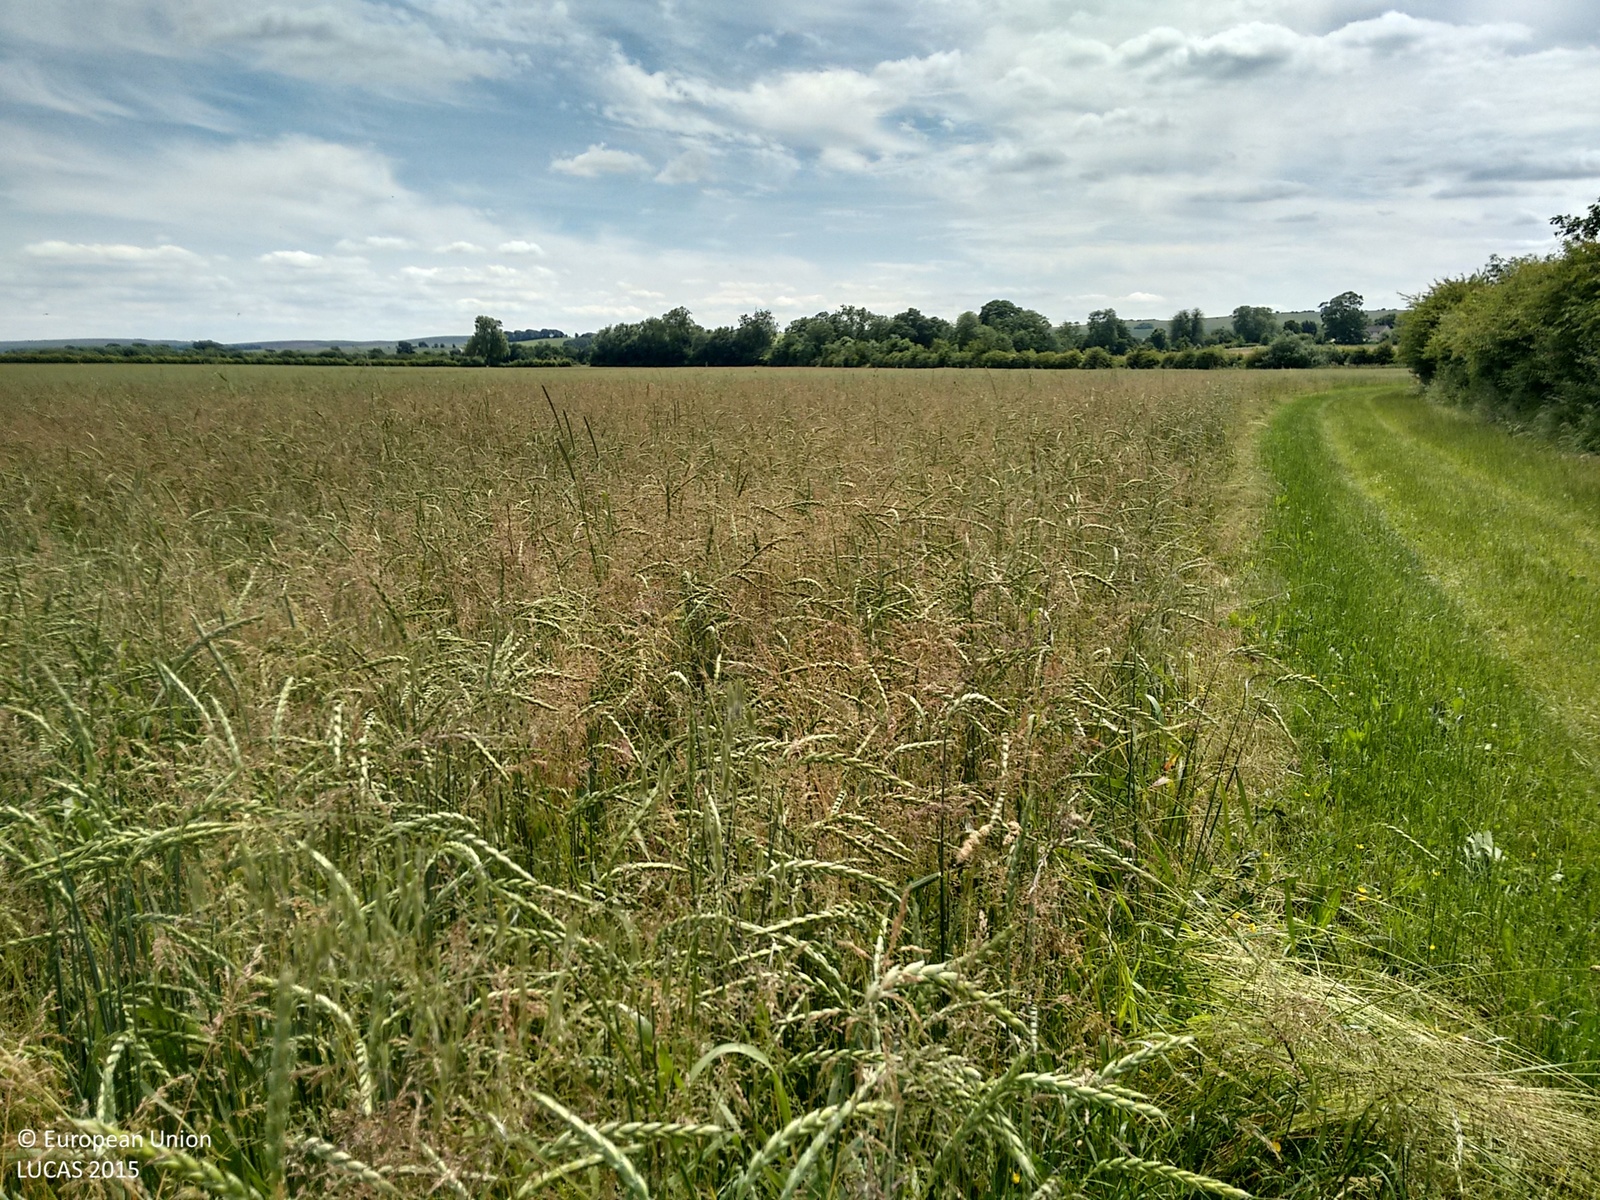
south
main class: Cropland
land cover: Mixed cereals for fodder
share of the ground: > 75 %
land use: Agriculture (excluding fallow land and kitchen gardens)
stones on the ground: < 10 %
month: June
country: GB
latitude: 51.4492
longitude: -1.8995
